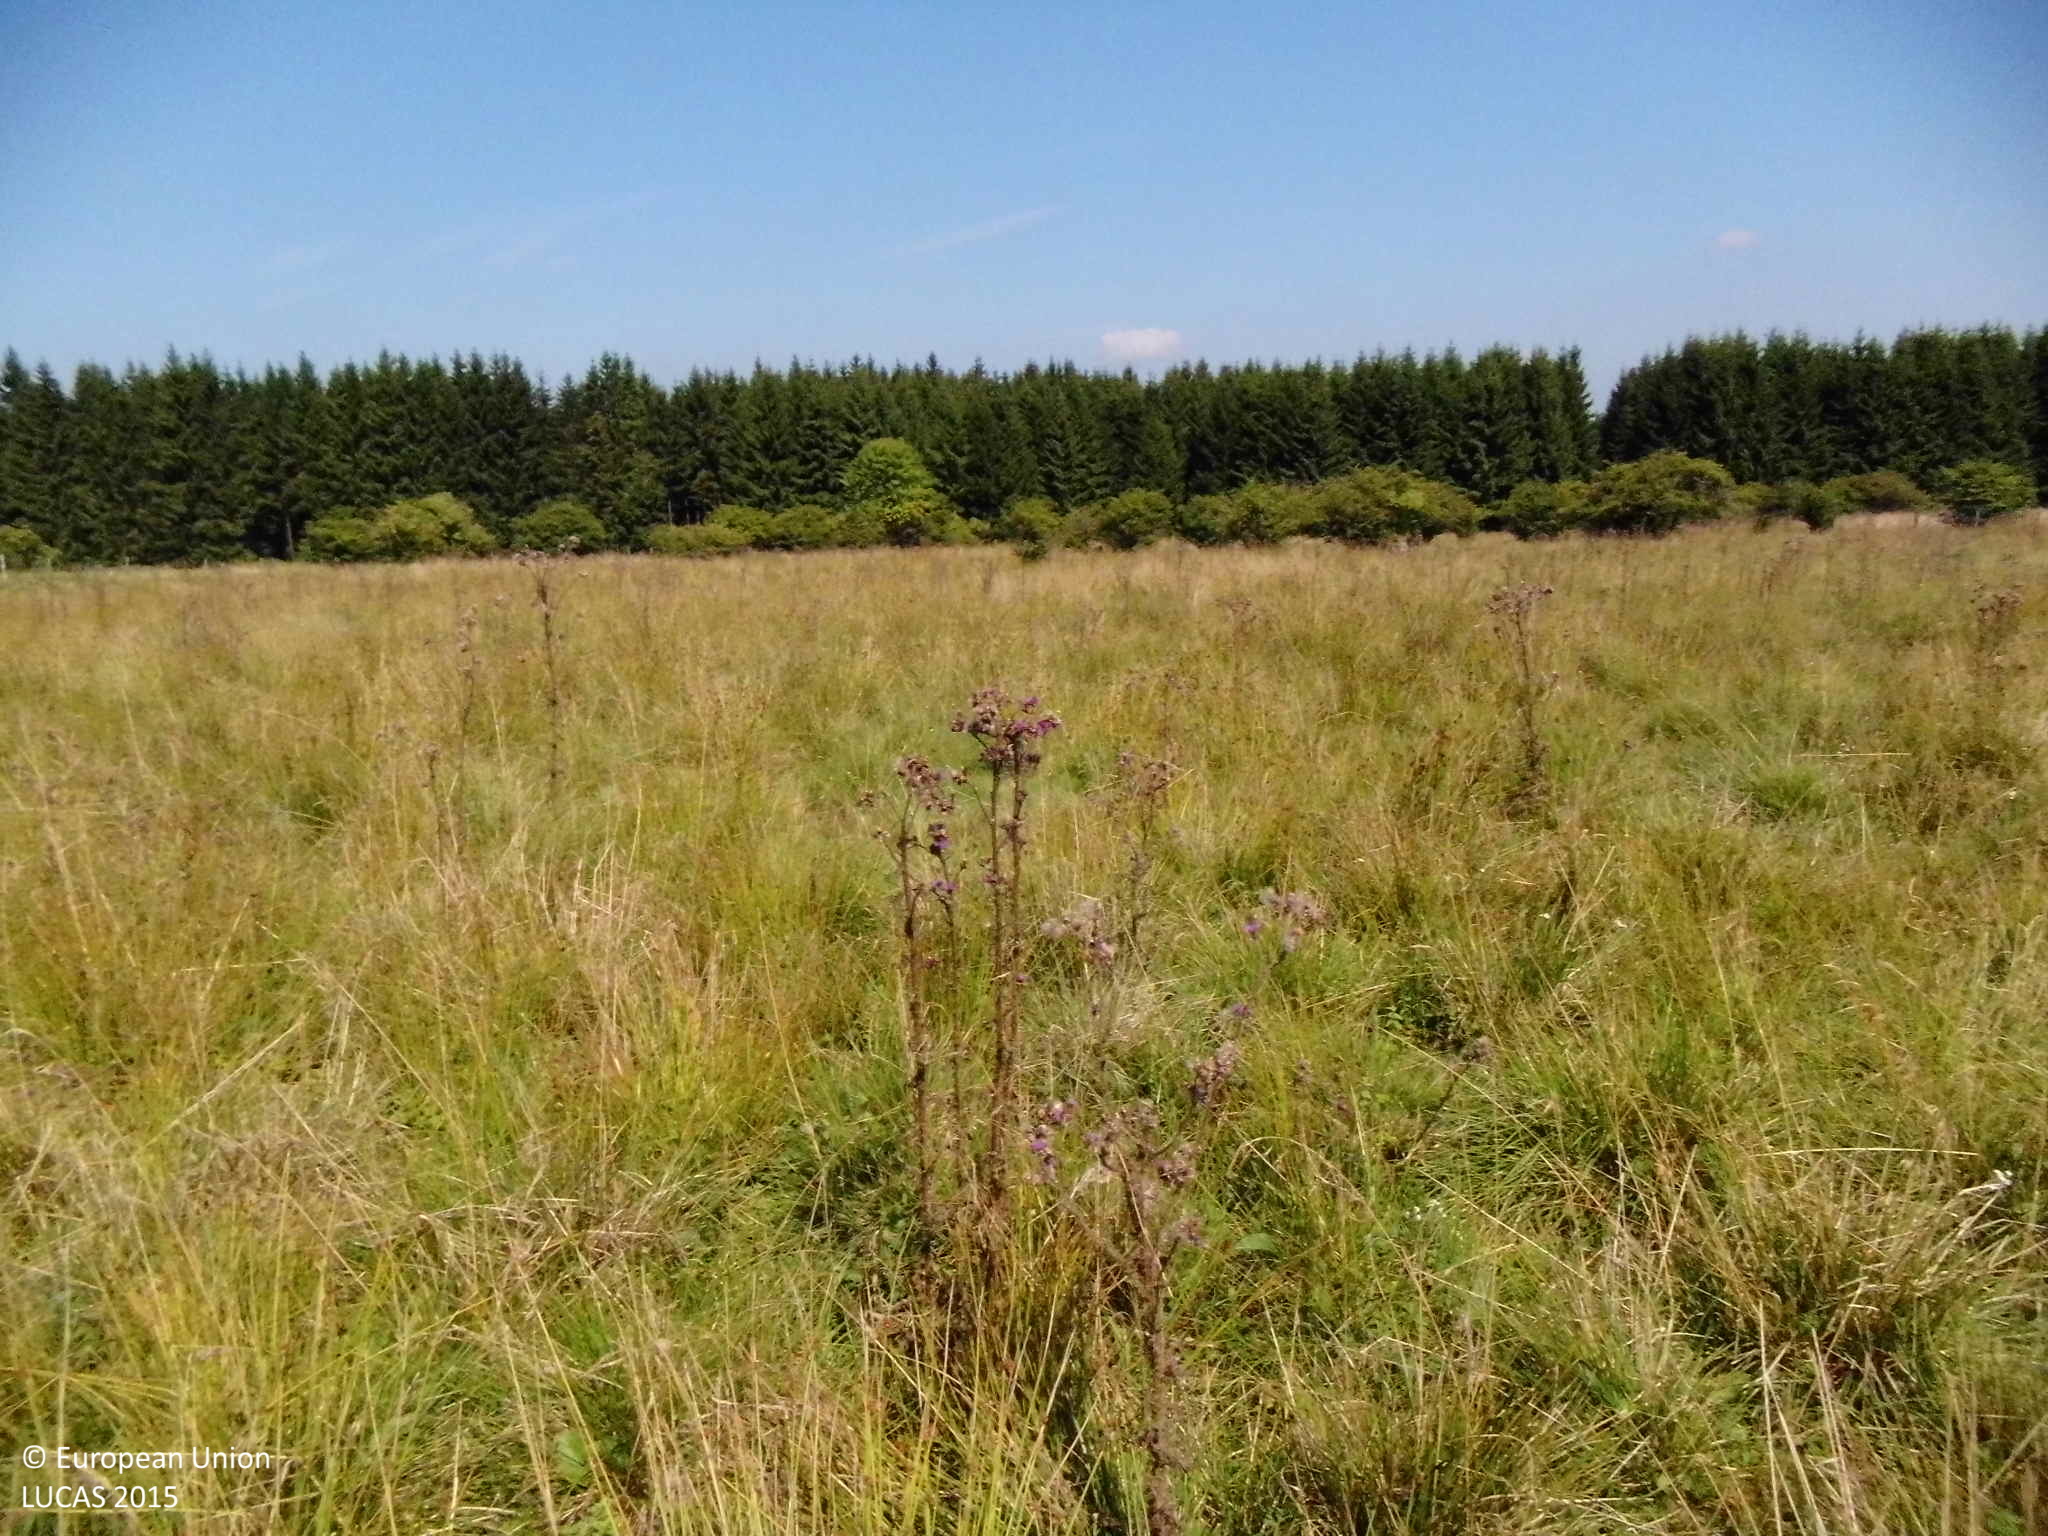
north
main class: Grassland
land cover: Spontaneously vegetated surfaces
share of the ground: > 75 %
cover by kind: herbaceous plants 95 %, shrubs 5 %
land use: Fallow land
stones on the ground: < 10 %
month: August
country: DE
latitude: 50.6723
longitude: 8.1184
